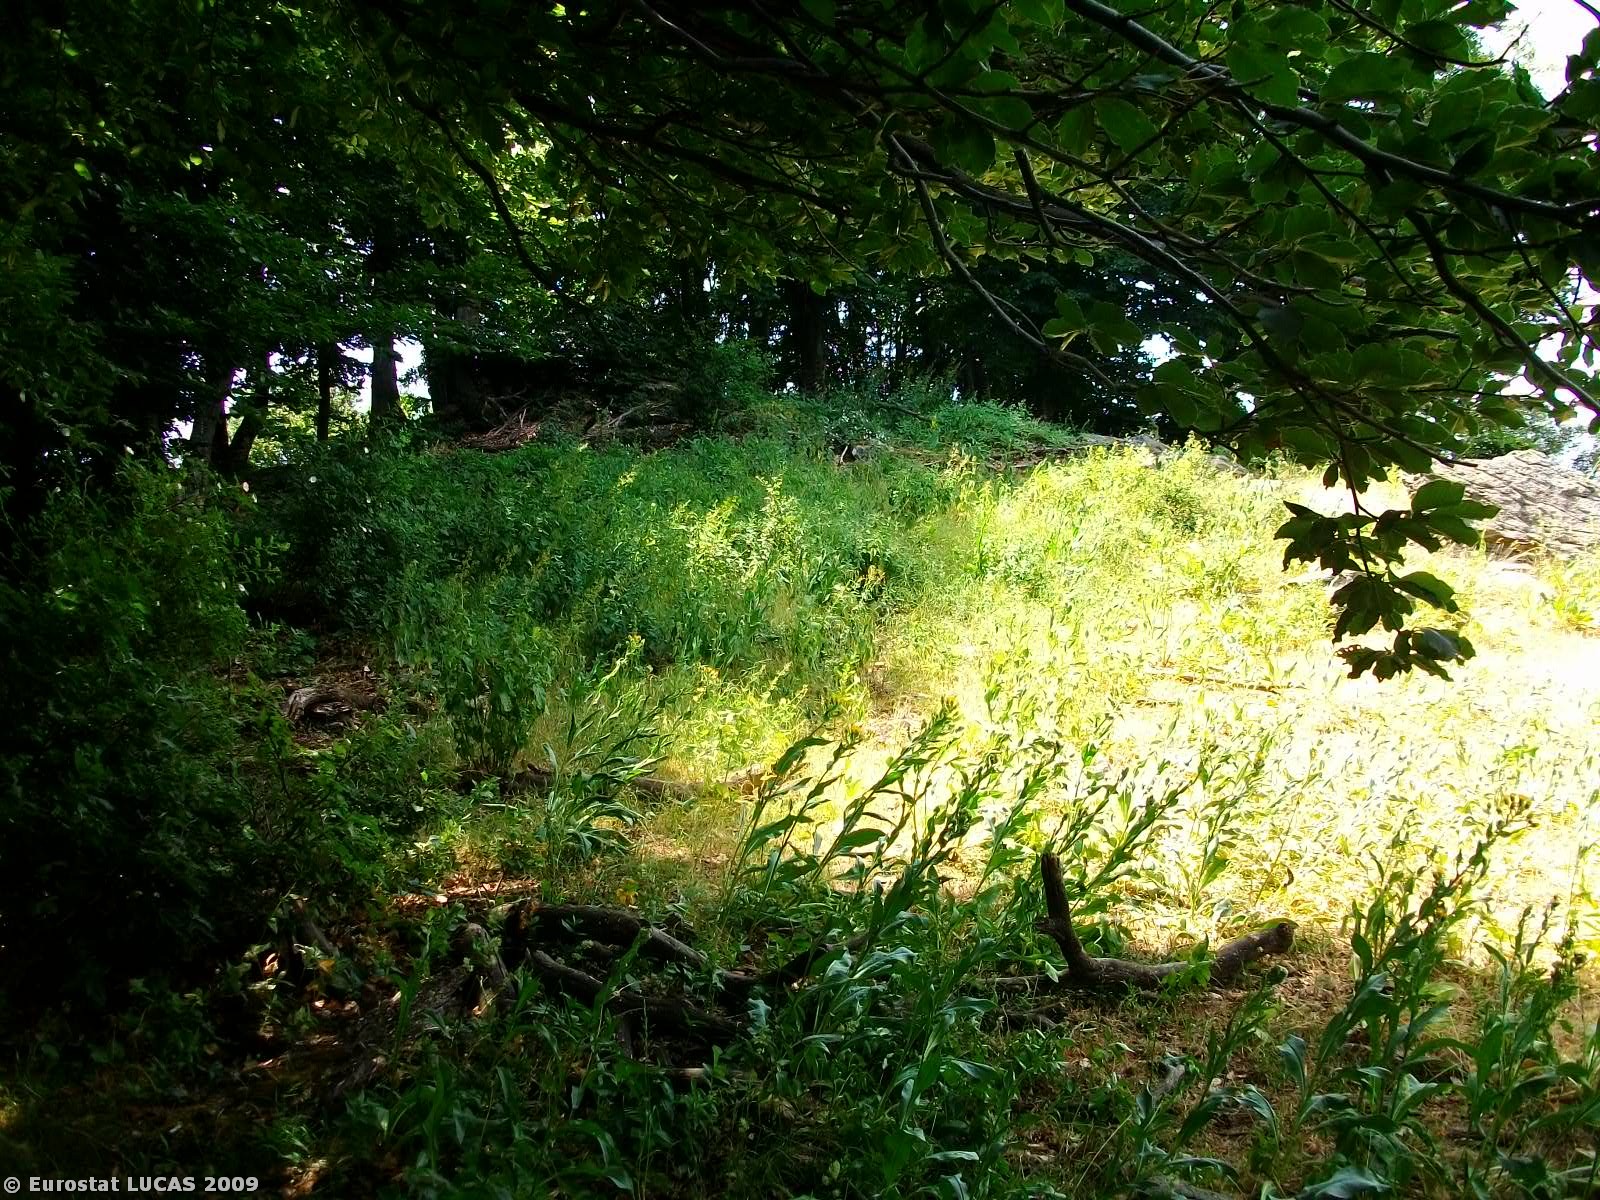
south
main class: Woodland
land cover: Broadleaved woodland
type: mountainous beech forest
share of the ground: 50 - 75 %
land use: Forestry
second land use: Agriculture (excluding fallow land and kitchen gardens)
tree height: > 5 m
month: June
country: GR
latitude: 41.1579
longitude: 25.8499
